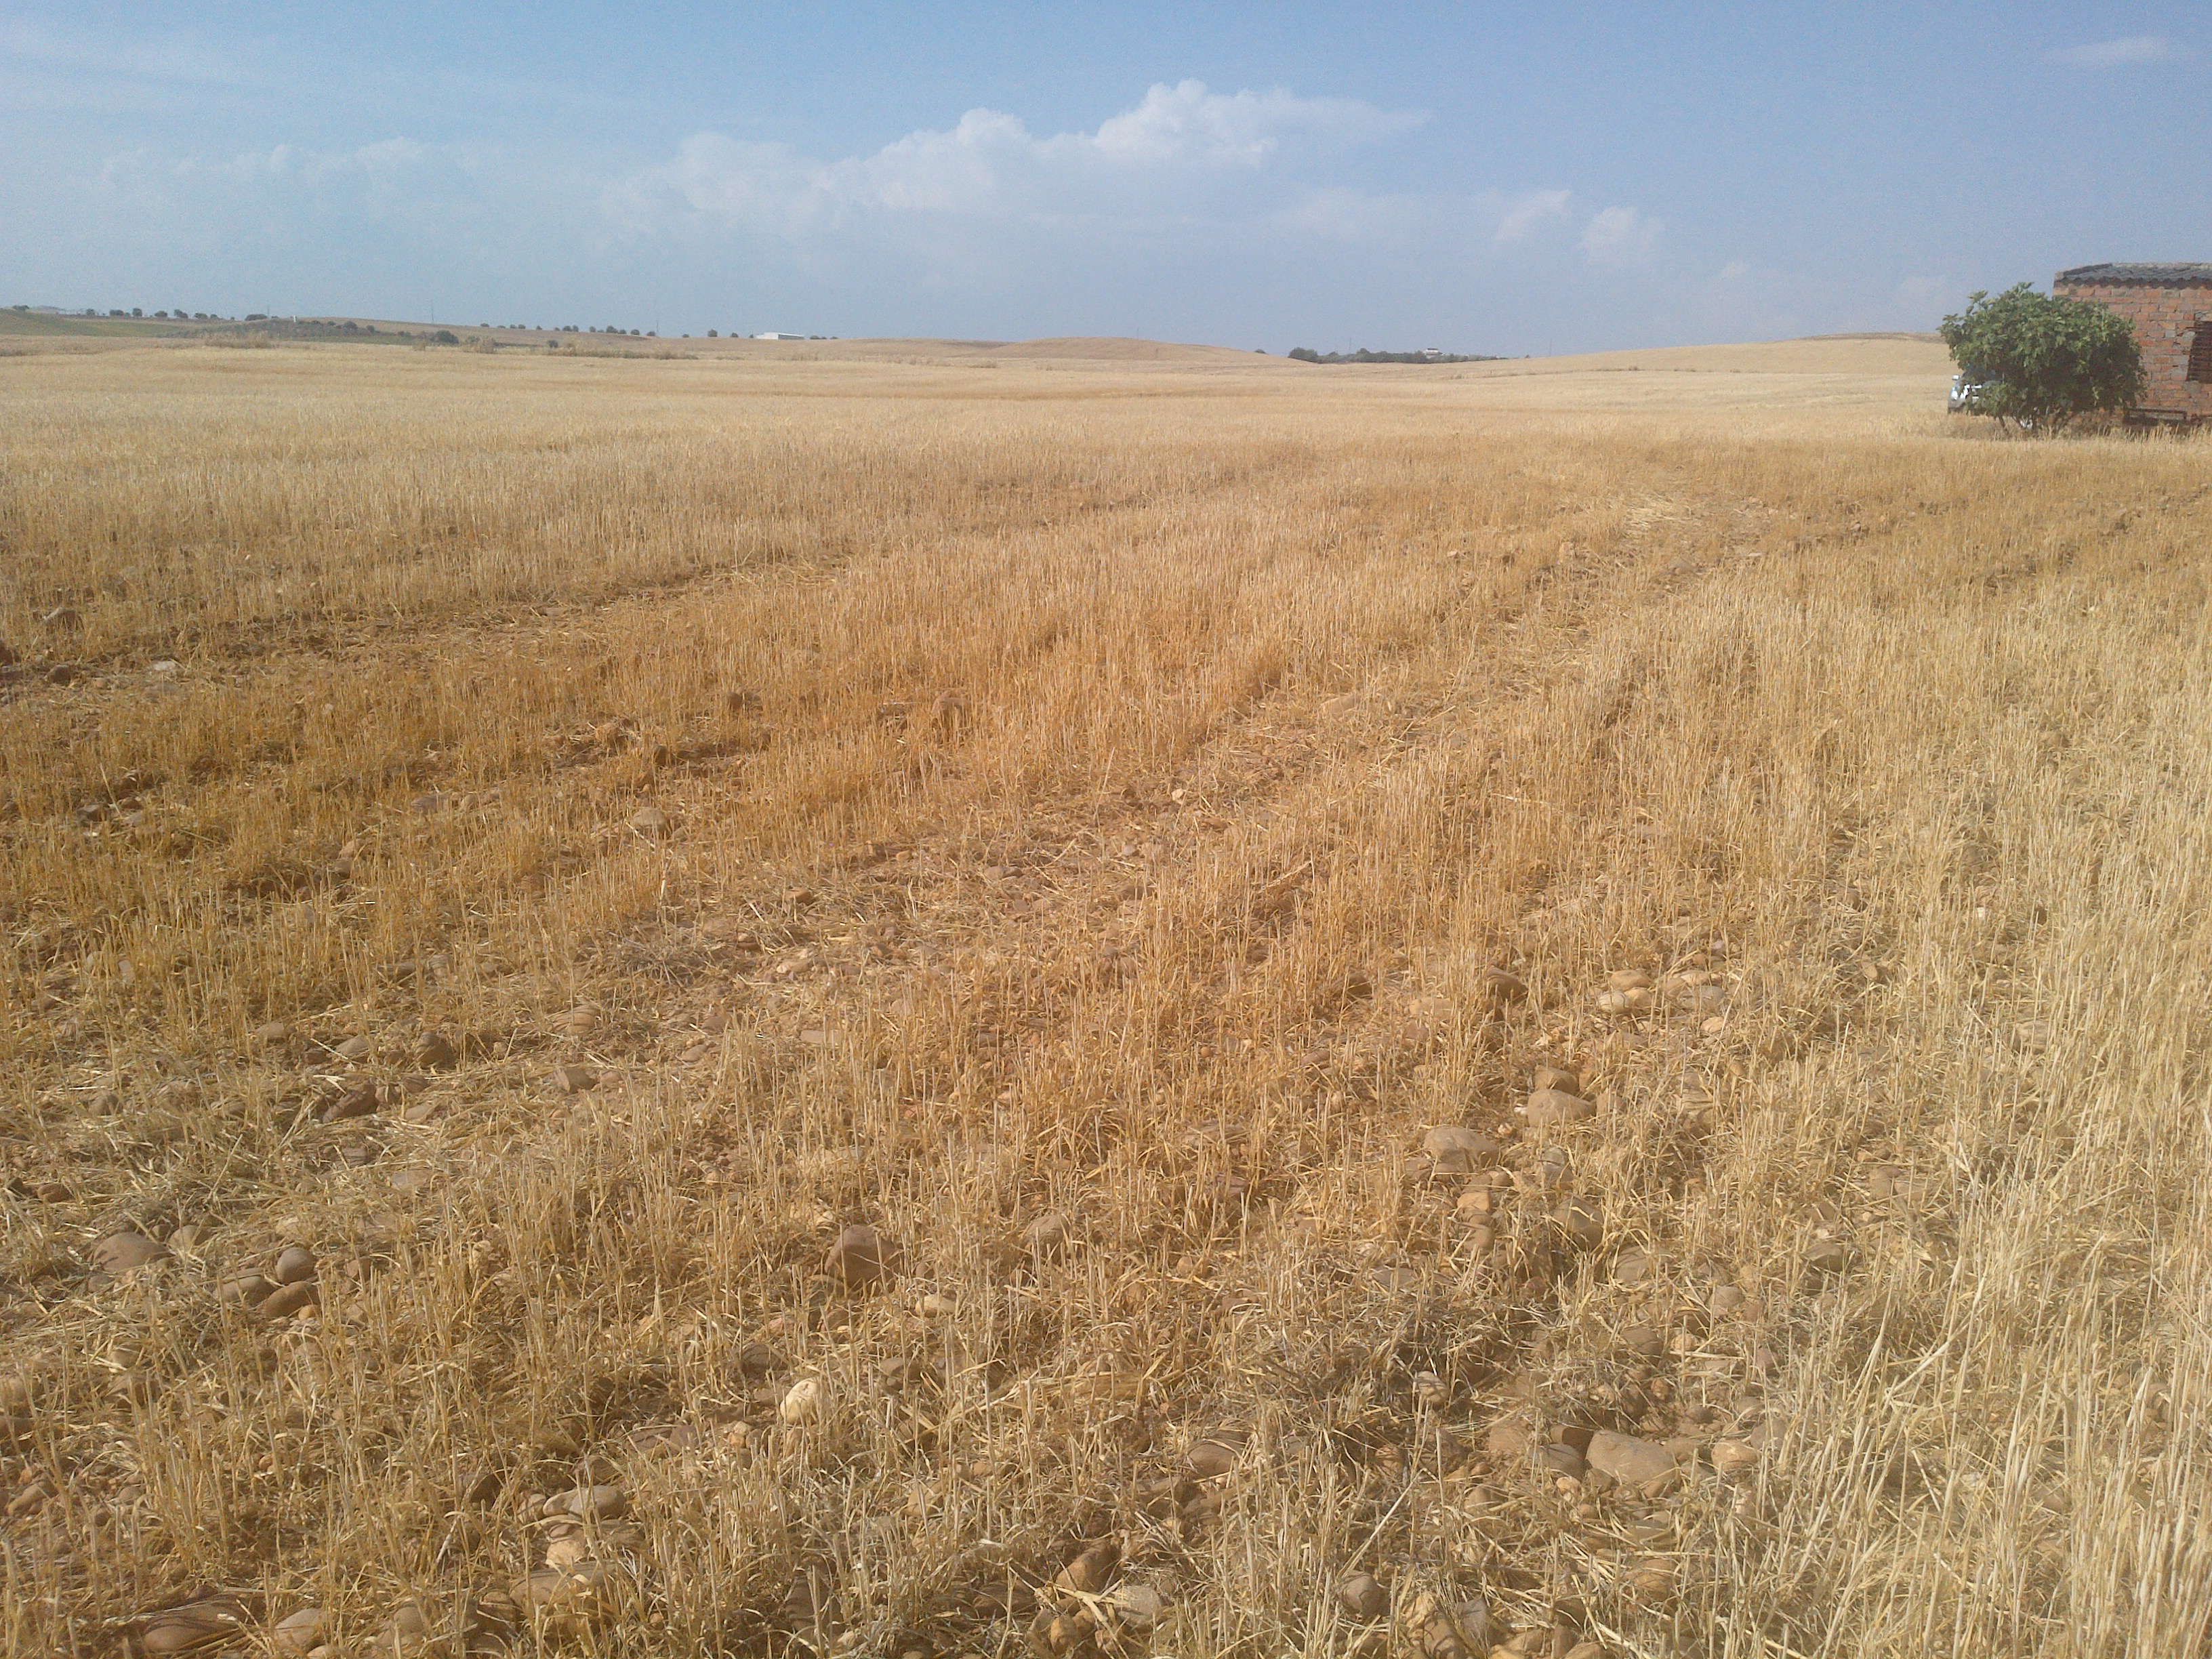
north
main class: Cropland
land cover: Durum wheat
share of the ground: < 10 %
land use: Agriculture (excluding fallow land and kitchen gardens)
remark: Harvested field
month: June
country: ES
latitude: 37.7383
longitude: -4.9363
